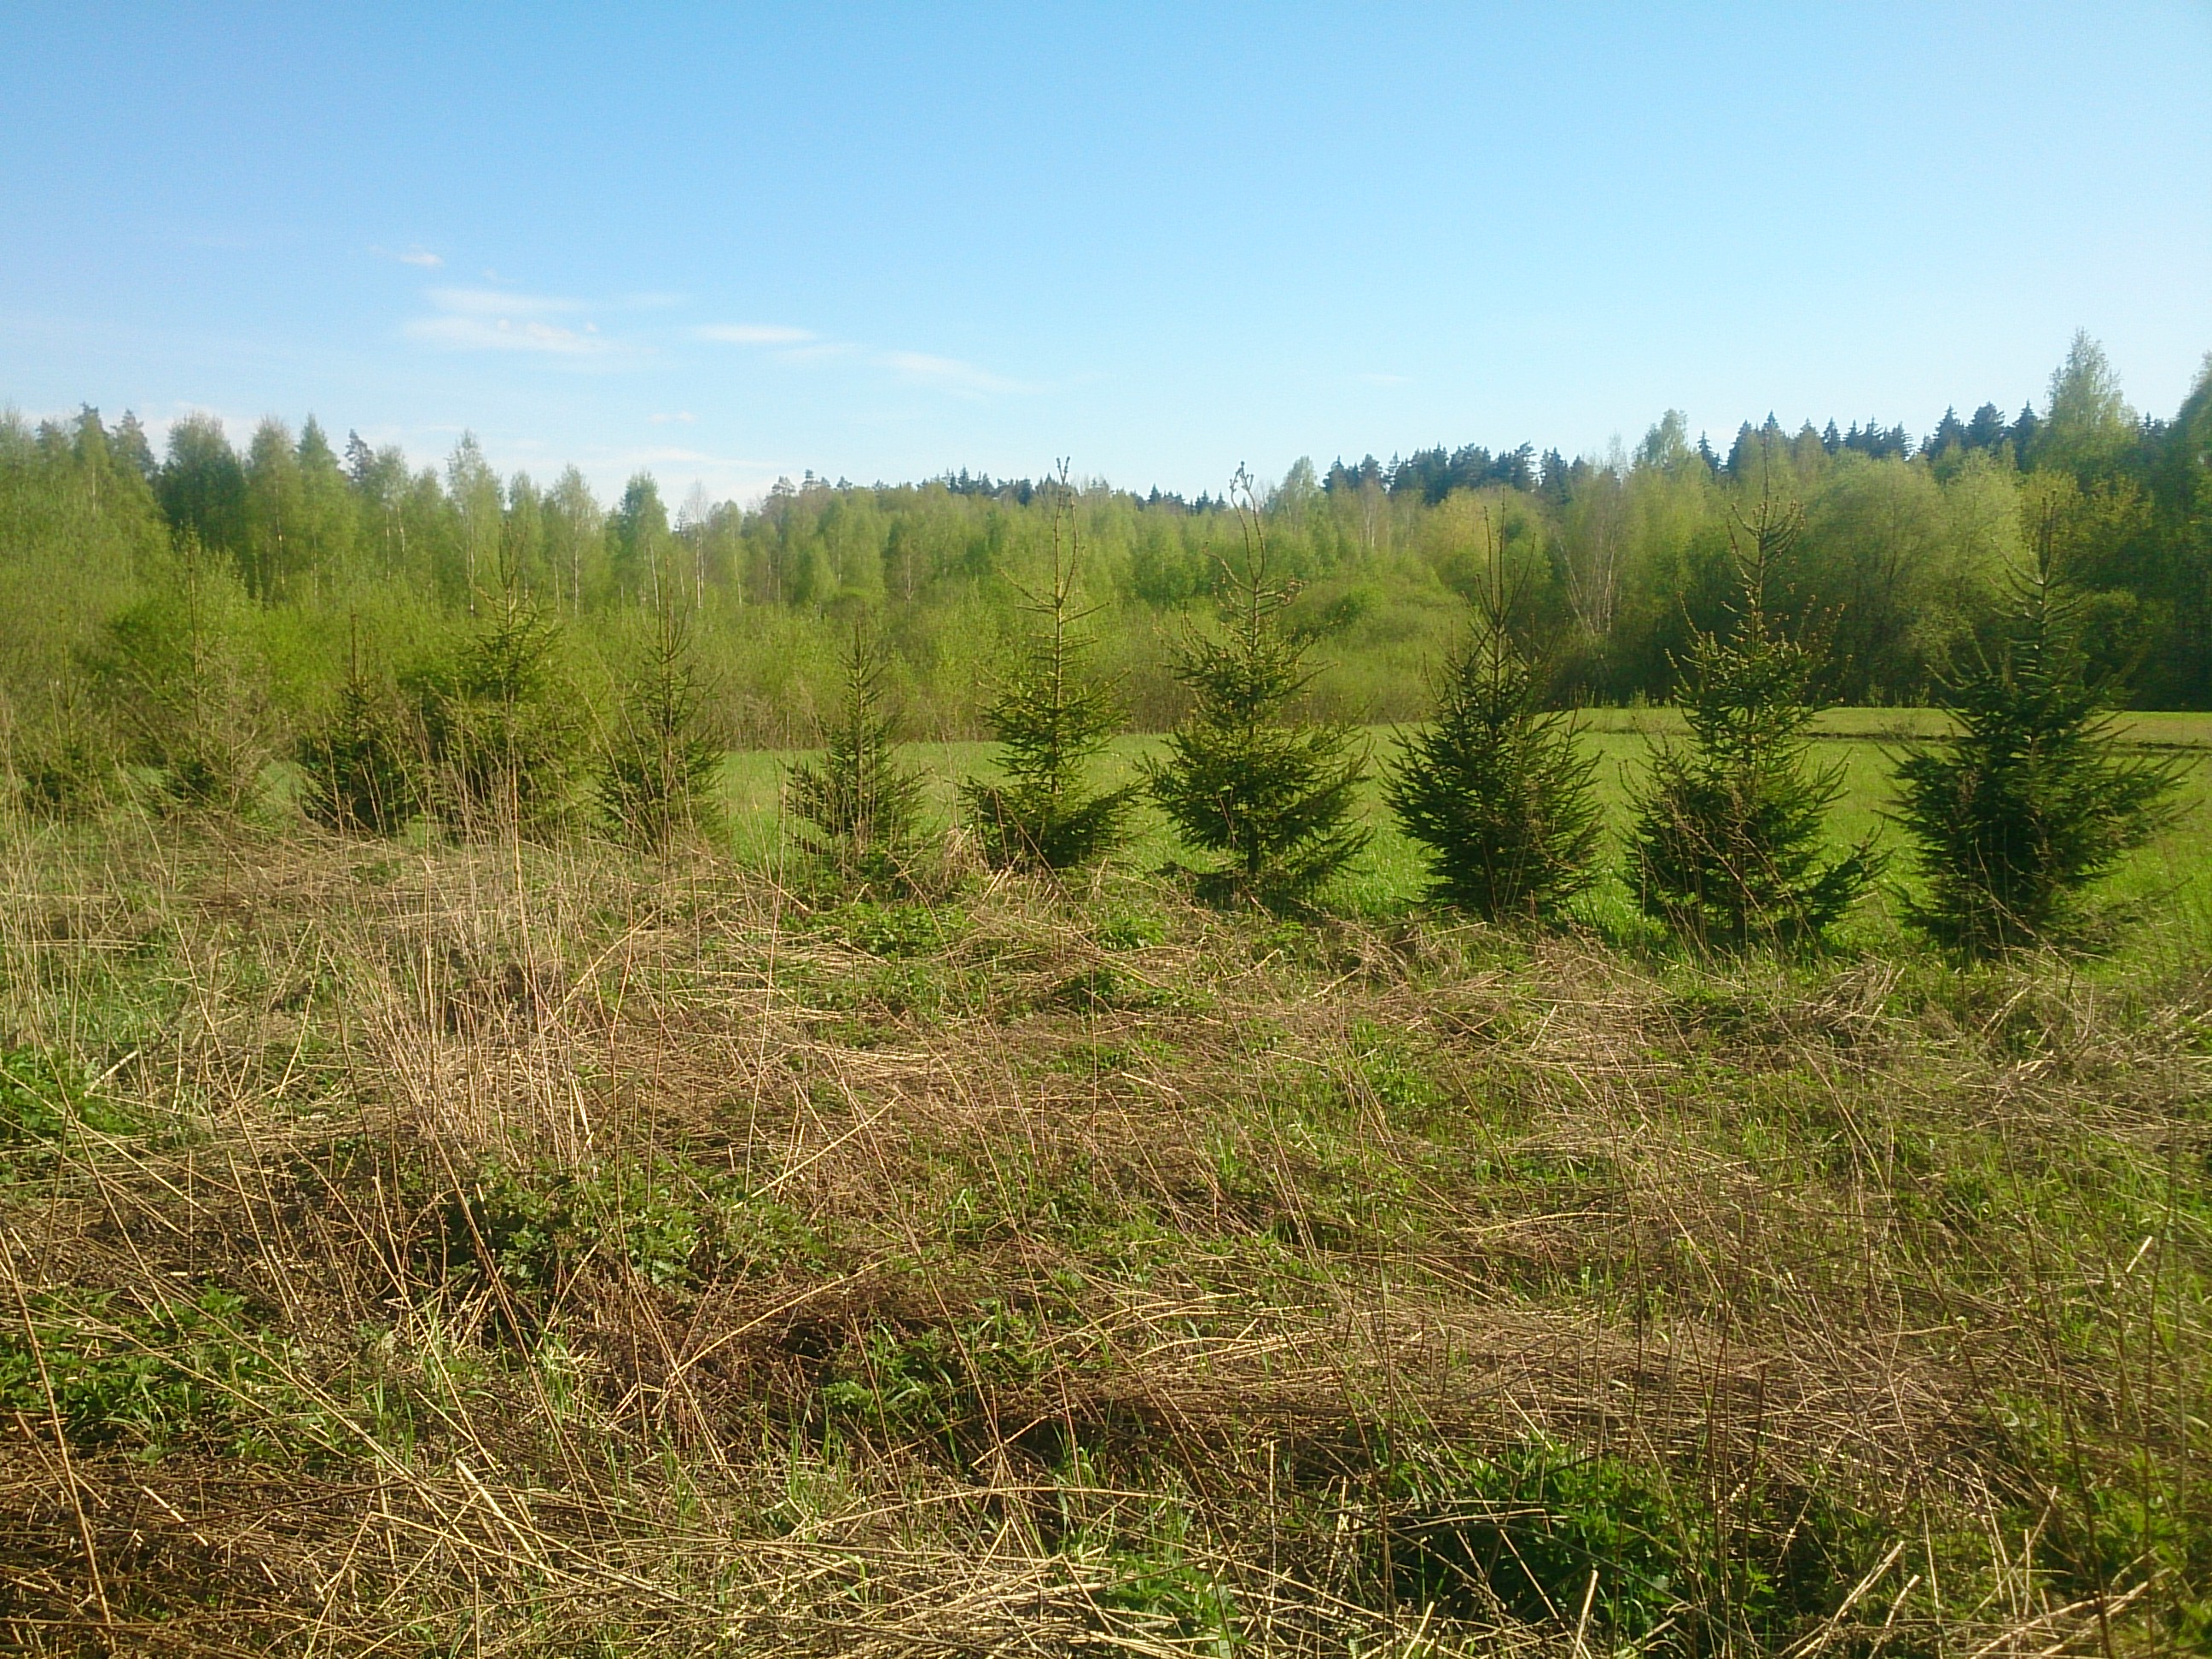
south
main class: Grassland
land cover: Spontaneously vegetated surfaces
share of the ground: > 75 %
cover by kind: herbaceous plants 100 %
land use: Agriculture (excluding fallow land and kitchen gardens)
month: May
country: LV
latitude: 56.7600
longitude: 24.4054
